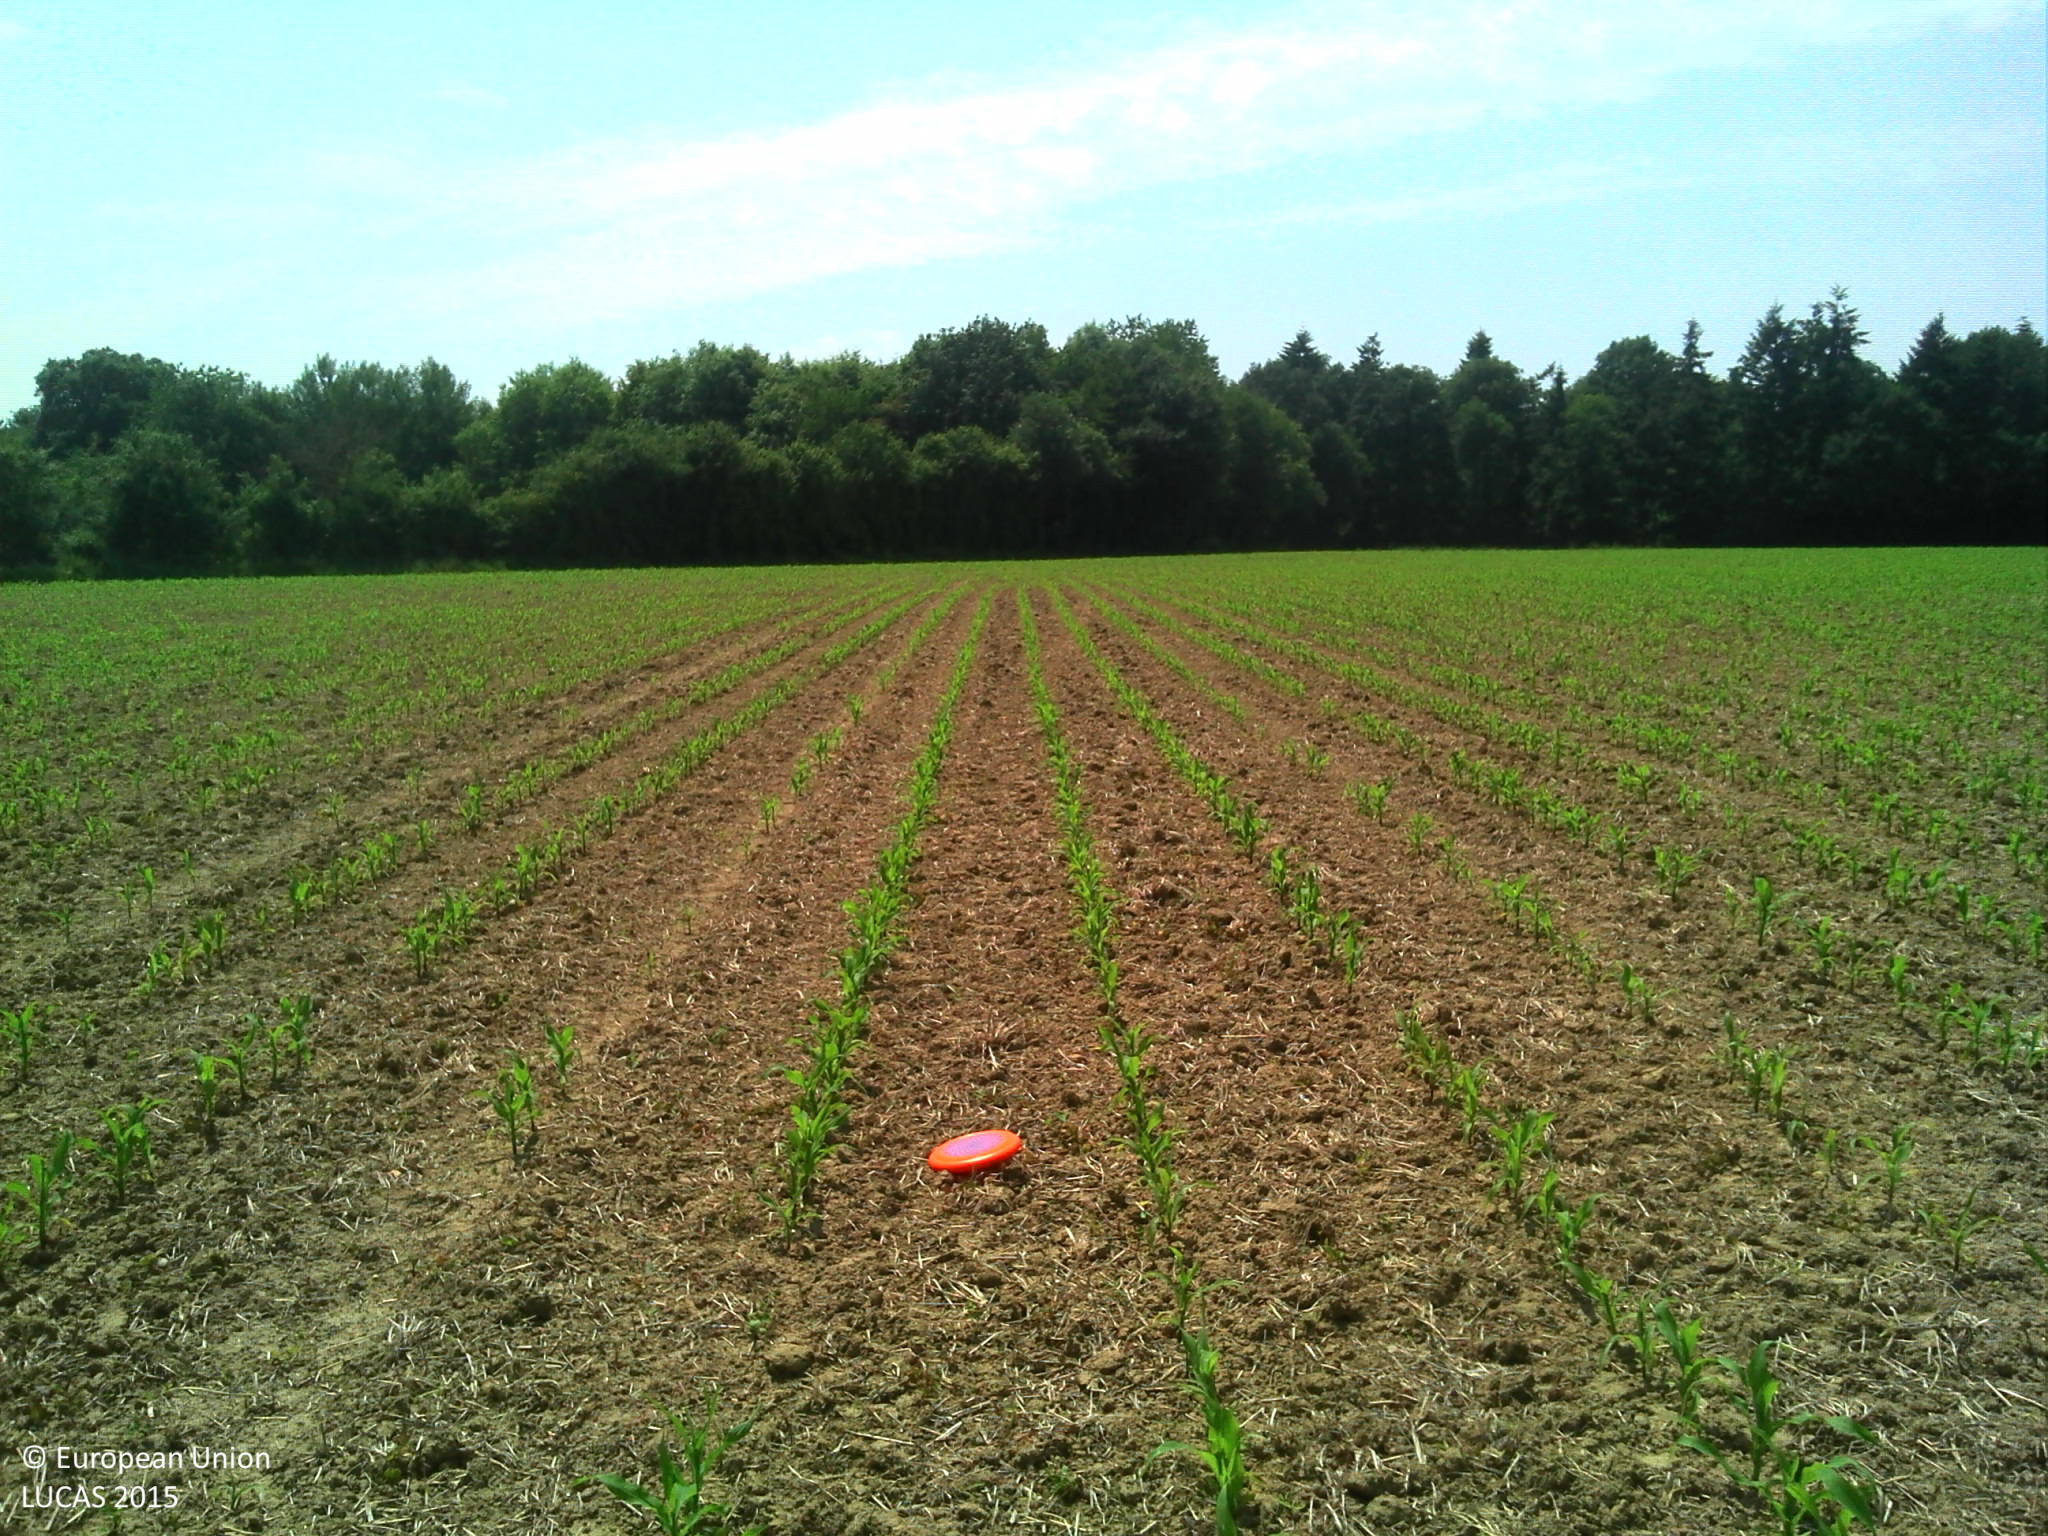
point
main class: Cropland
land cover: Maize
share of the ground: 25 - 50 %
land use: Agriculture (excluding fallow land and kitchen gardens)
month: June
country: FR
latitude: 47.9512
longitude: 0.0237
